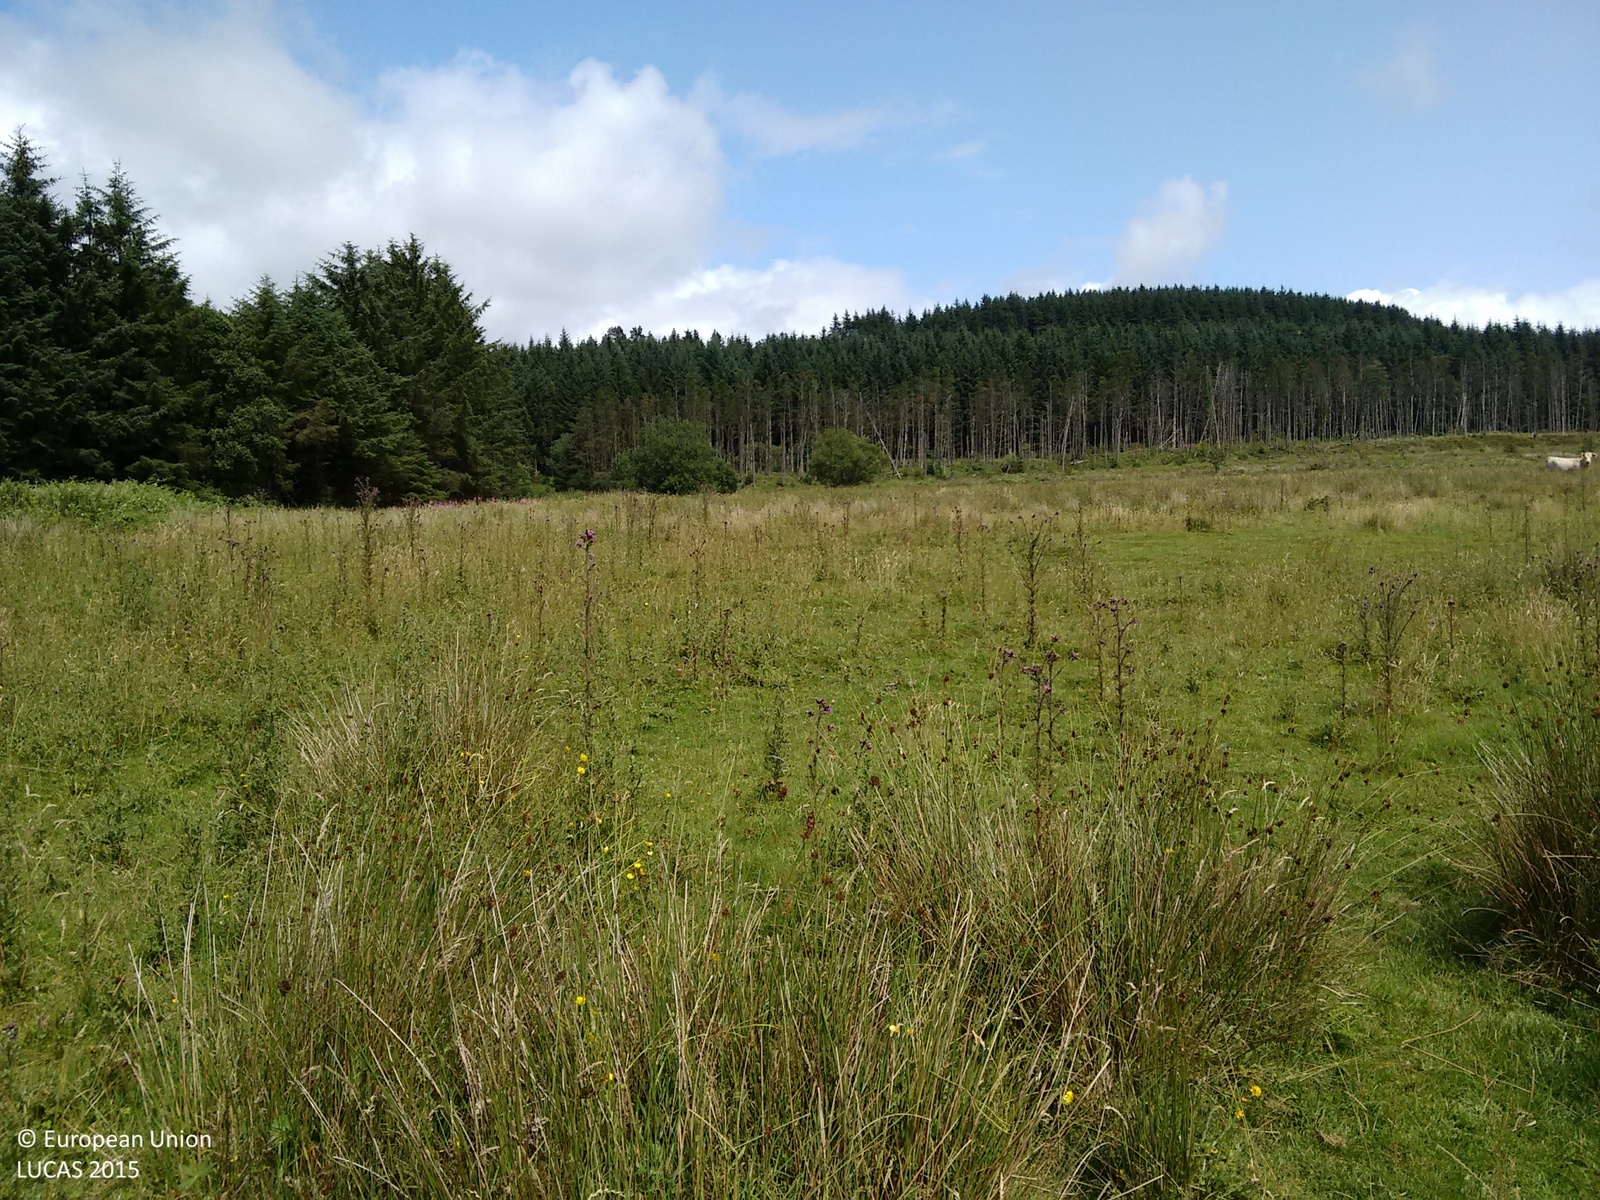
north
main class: Grassland
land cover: Grassland without tree/shrub cover
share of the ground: > 75 %
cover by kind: herbaceous plants 100 %
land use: Agriculture (excluding fallow land and kitchen gardens)
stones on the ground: < 10 %
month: July
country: GB
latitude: 51.6172
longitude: -3.6785
